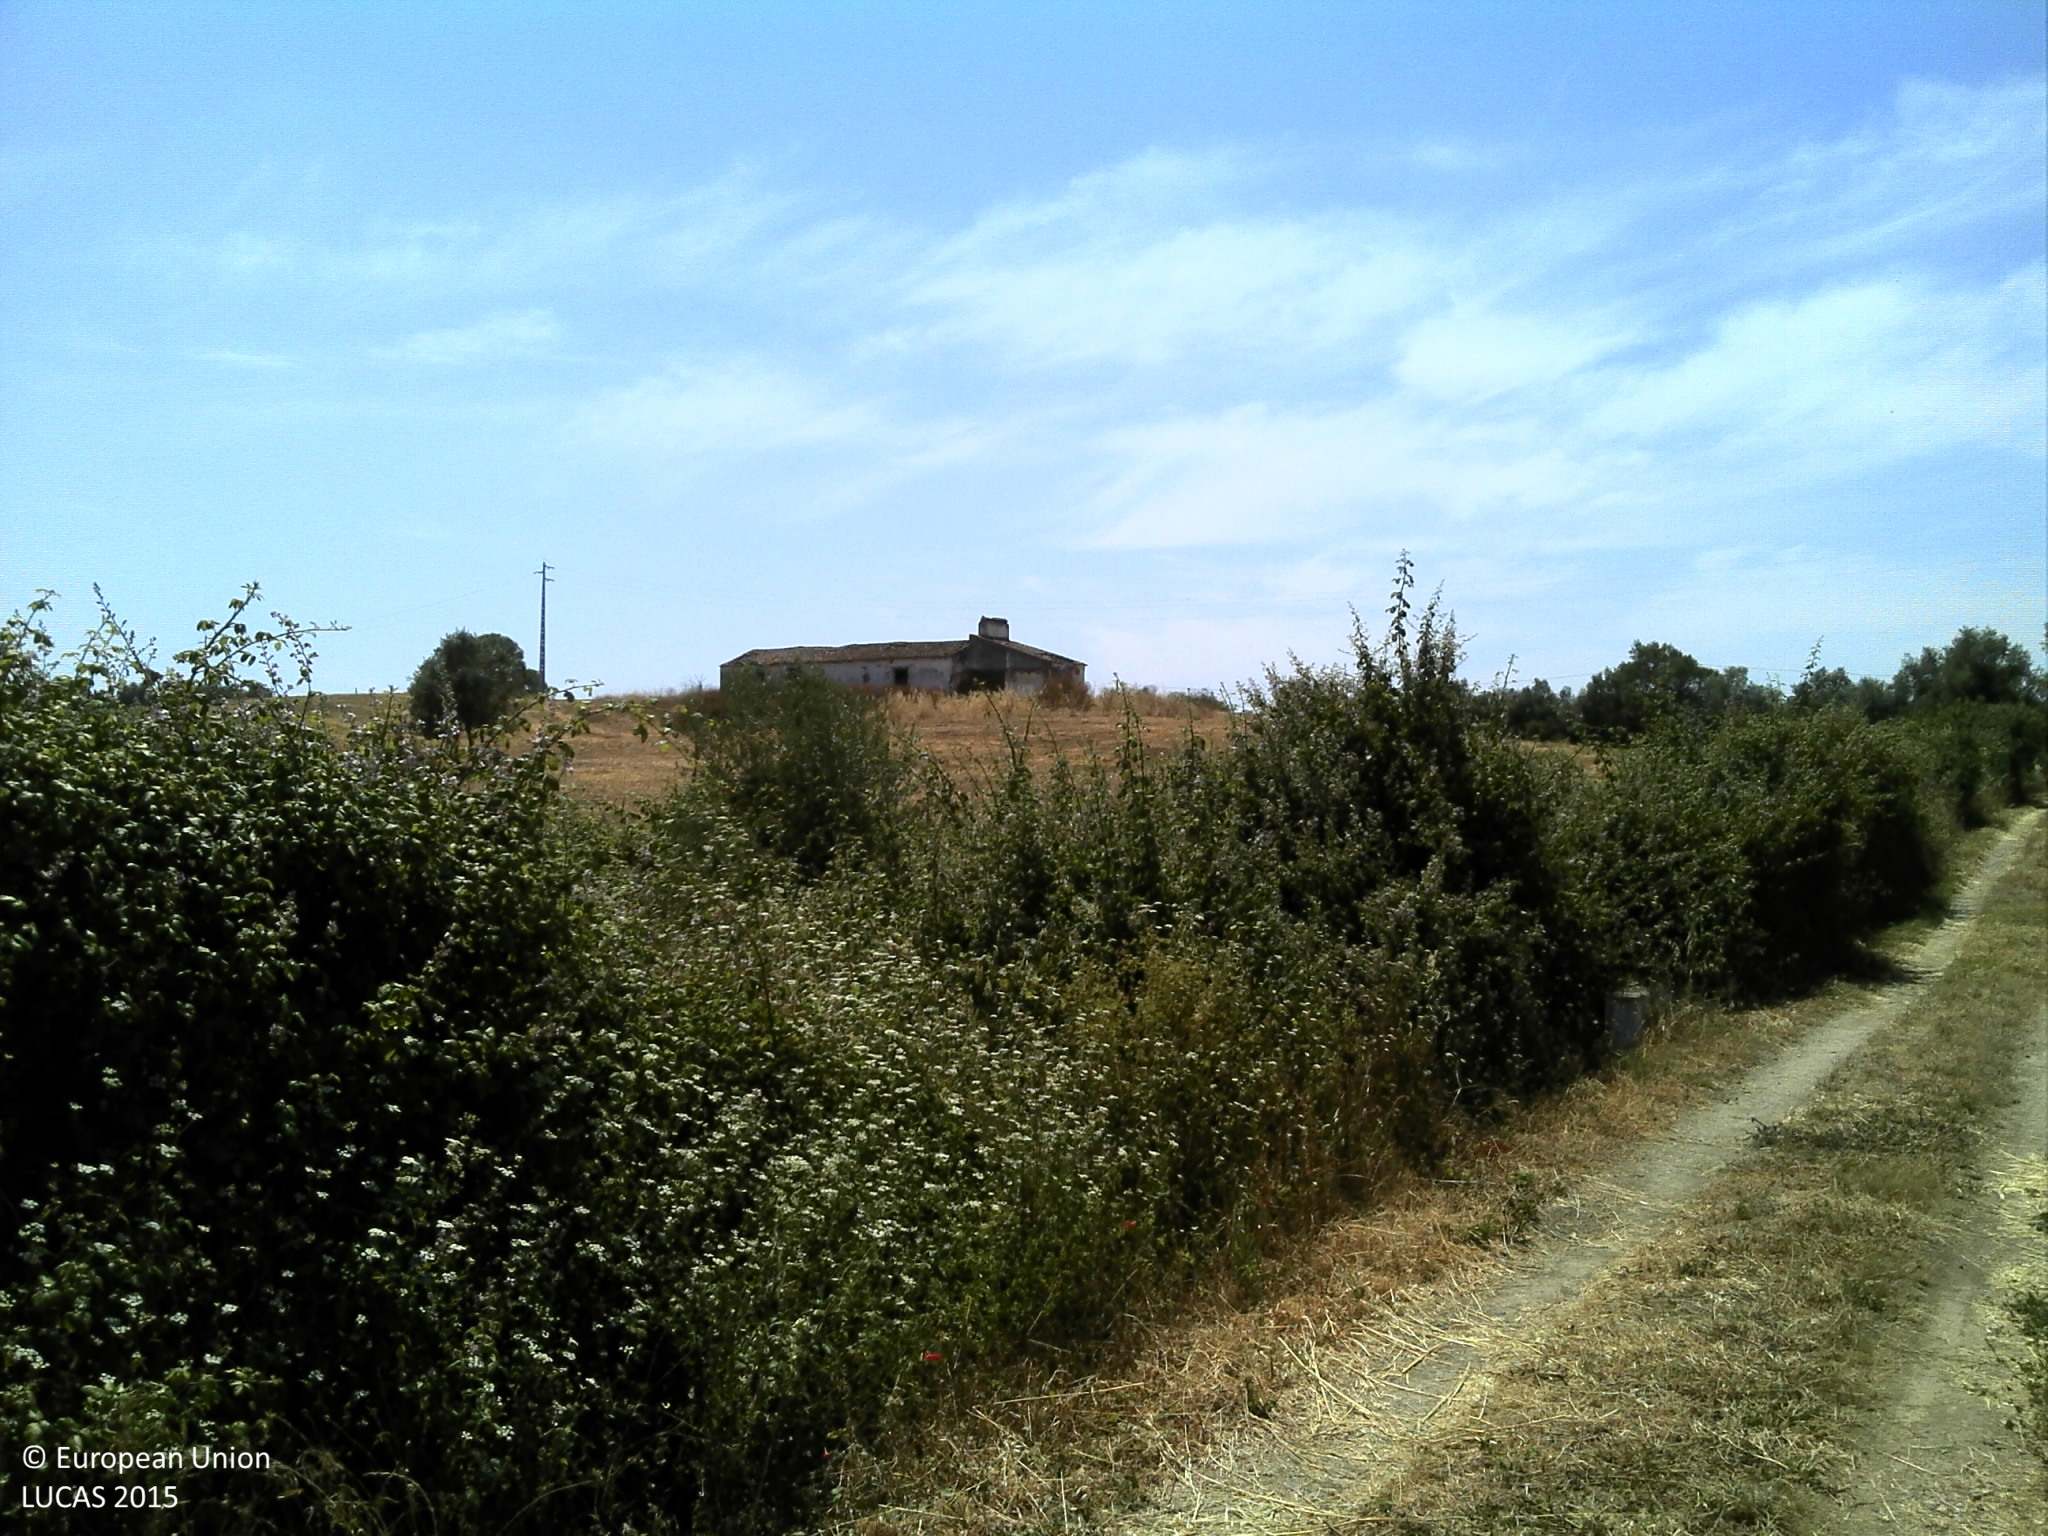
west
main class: Grassland
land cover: Spontaneously vegetated surfaces
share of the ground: < 10 %
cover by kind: unconsolidated bare surface 90 %, herbaceous plants 10 %
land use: Fallow land
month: June
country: PT
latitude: 38.6346
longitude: -8.2341
